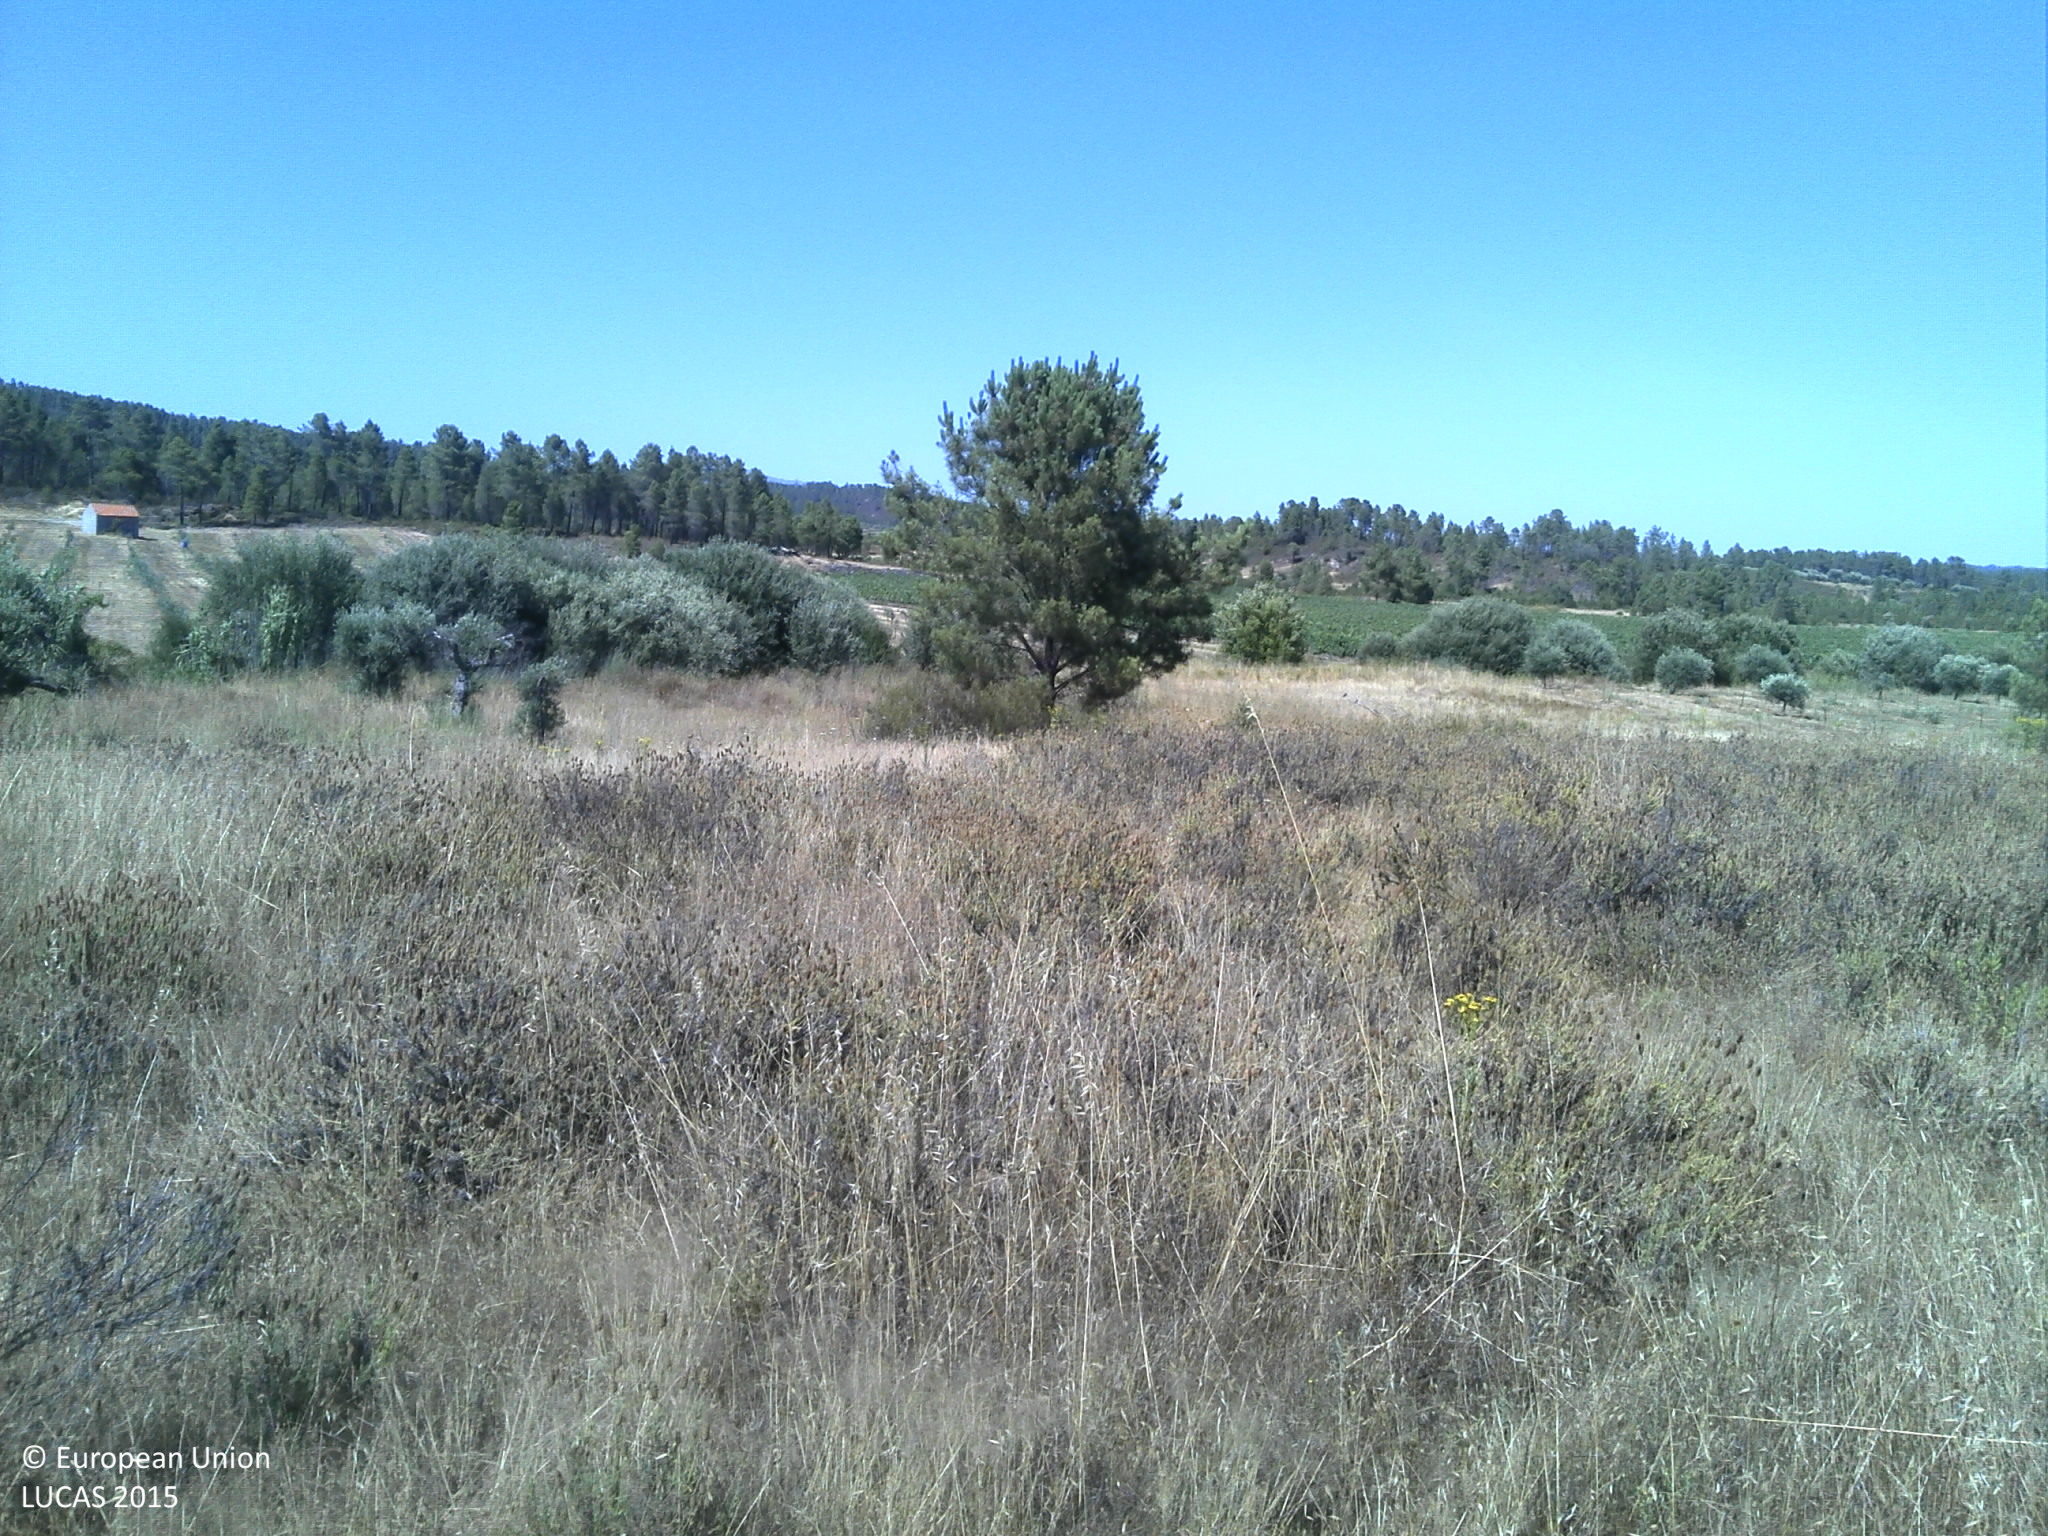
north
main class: Grassland
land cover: Grassland with sparse tree/shrub cover
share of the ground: 25 - 50 %
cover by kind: herbaceous plants 50 %, unconsolidated bare surface 40 %, broadleaved forest trees 5 %, shrubs 5 %
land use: Agriculture (excluding fallow land and kitchen gardens)
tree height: < 5 m
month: July
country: PT
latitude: 39.8711
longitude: -7.6525
